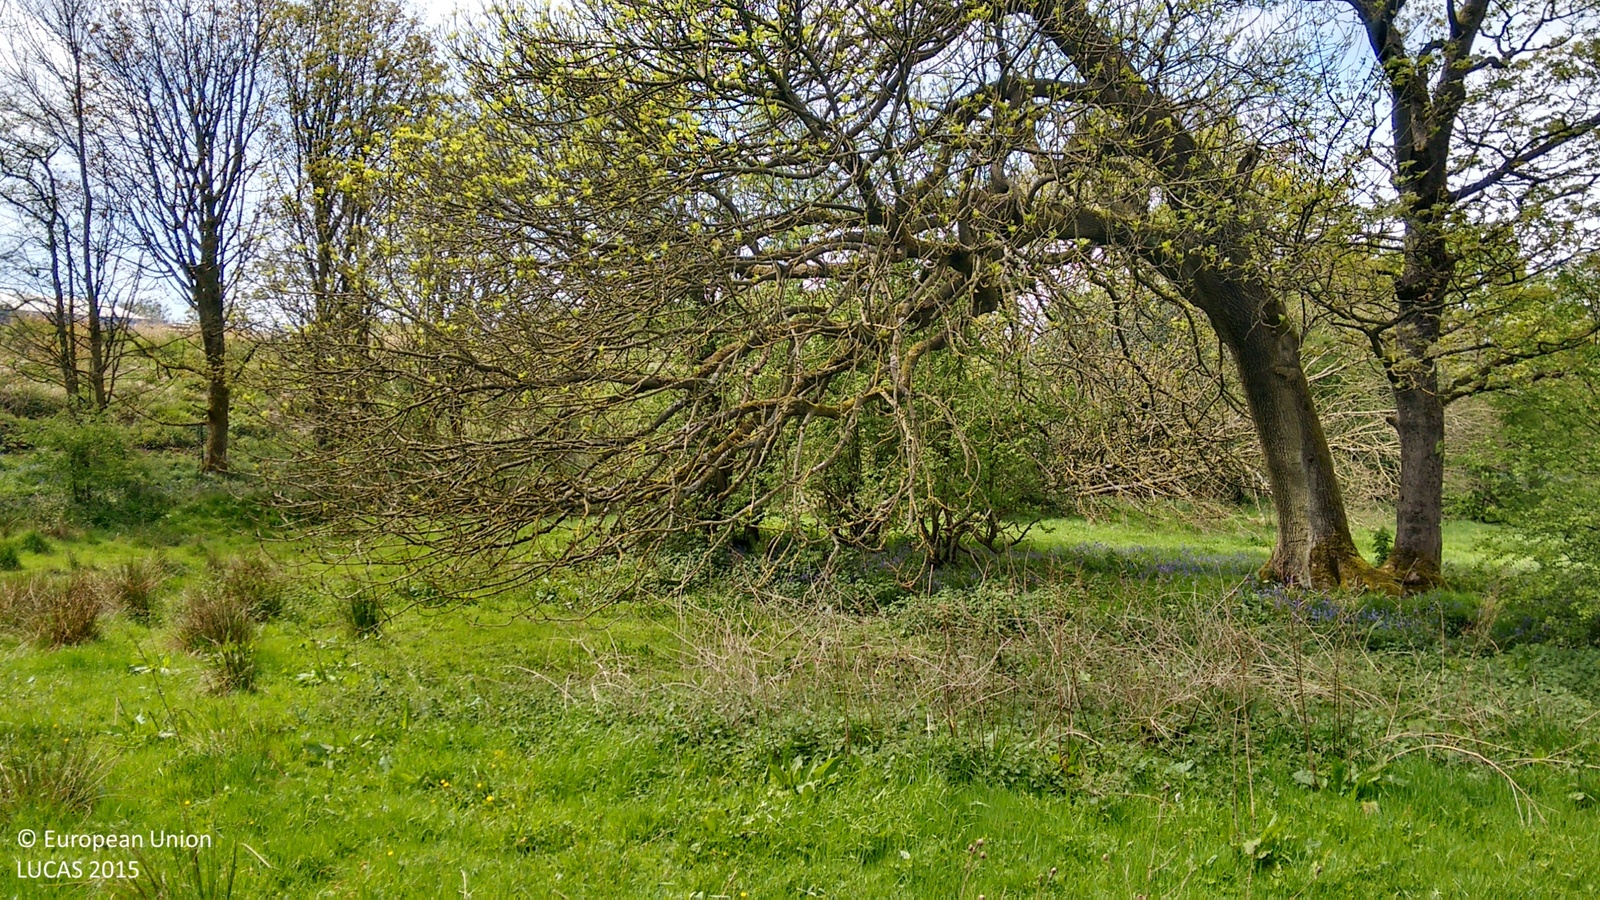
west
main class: Grassland
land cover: Grassland without tree/shrub cover
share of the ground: > 75 %
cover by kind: herbaceous plants 100 %
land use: Agriculture (excluding fallow land and kitchen gardens)
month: May
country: GB
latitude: 53.6500
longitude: -2.6090
